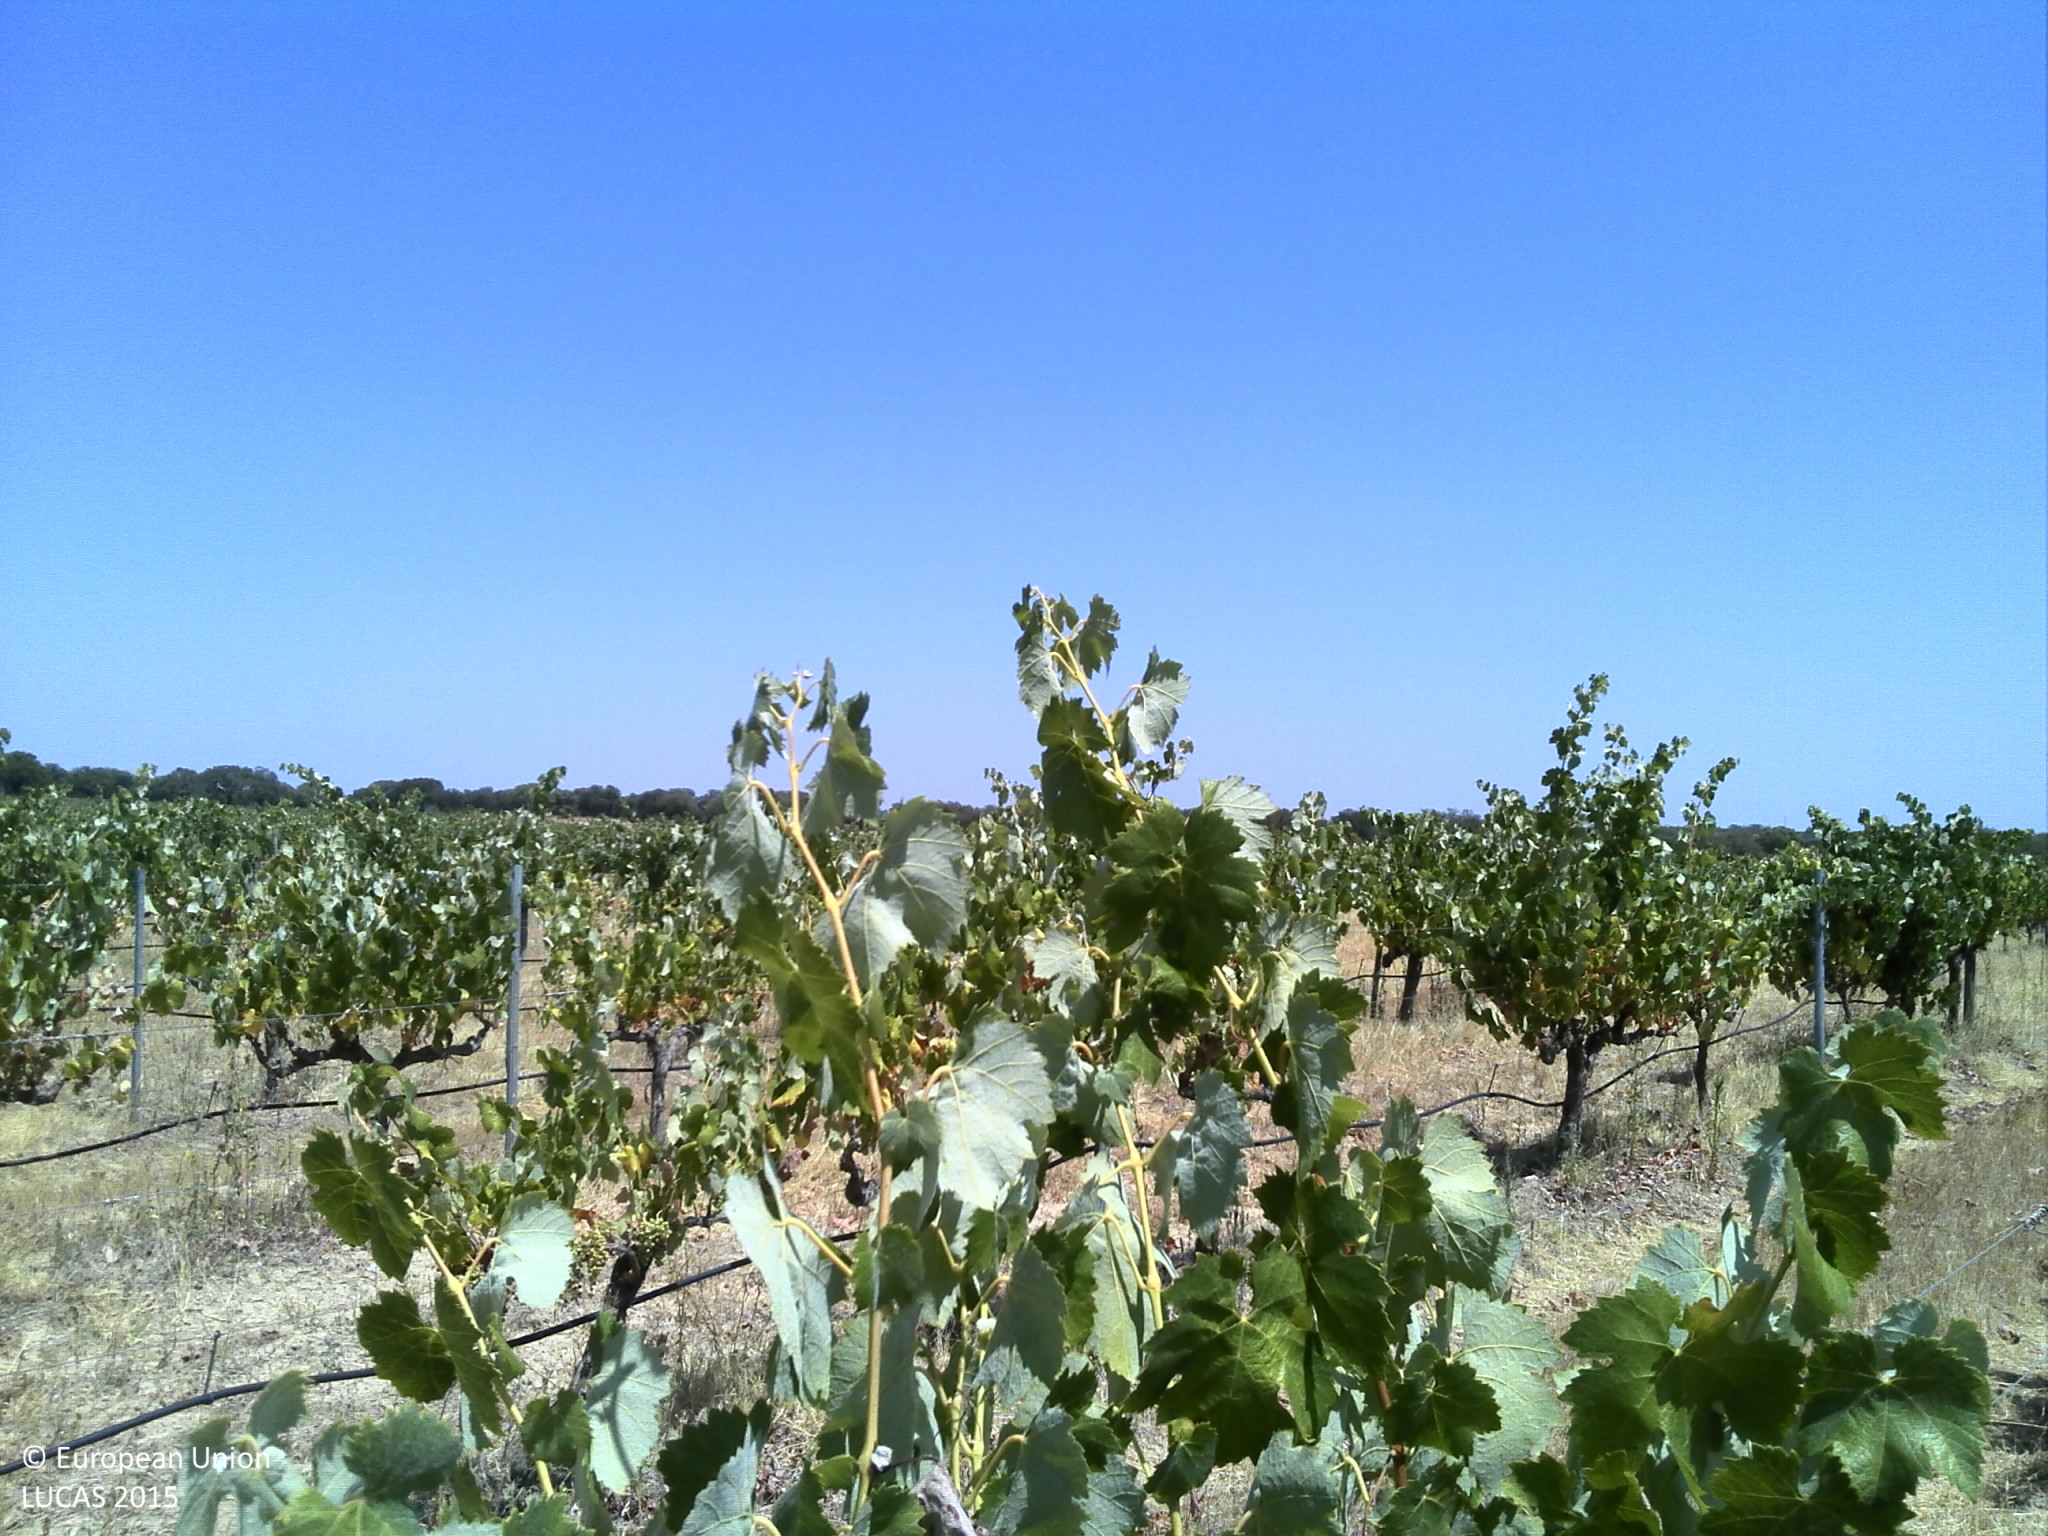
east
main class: Cropland
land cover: Vineyards
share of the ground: 25 - 50 %
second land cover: Other bare soil
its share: > 75 %
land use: Agriculture (excluding fallow land and kitchen gardens)
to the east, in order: Vineyards; Other bare soil; Tracks; Vineyards; Tracks; Vineyards
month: July
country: PT
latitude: 38.6911
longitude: -7.5428
